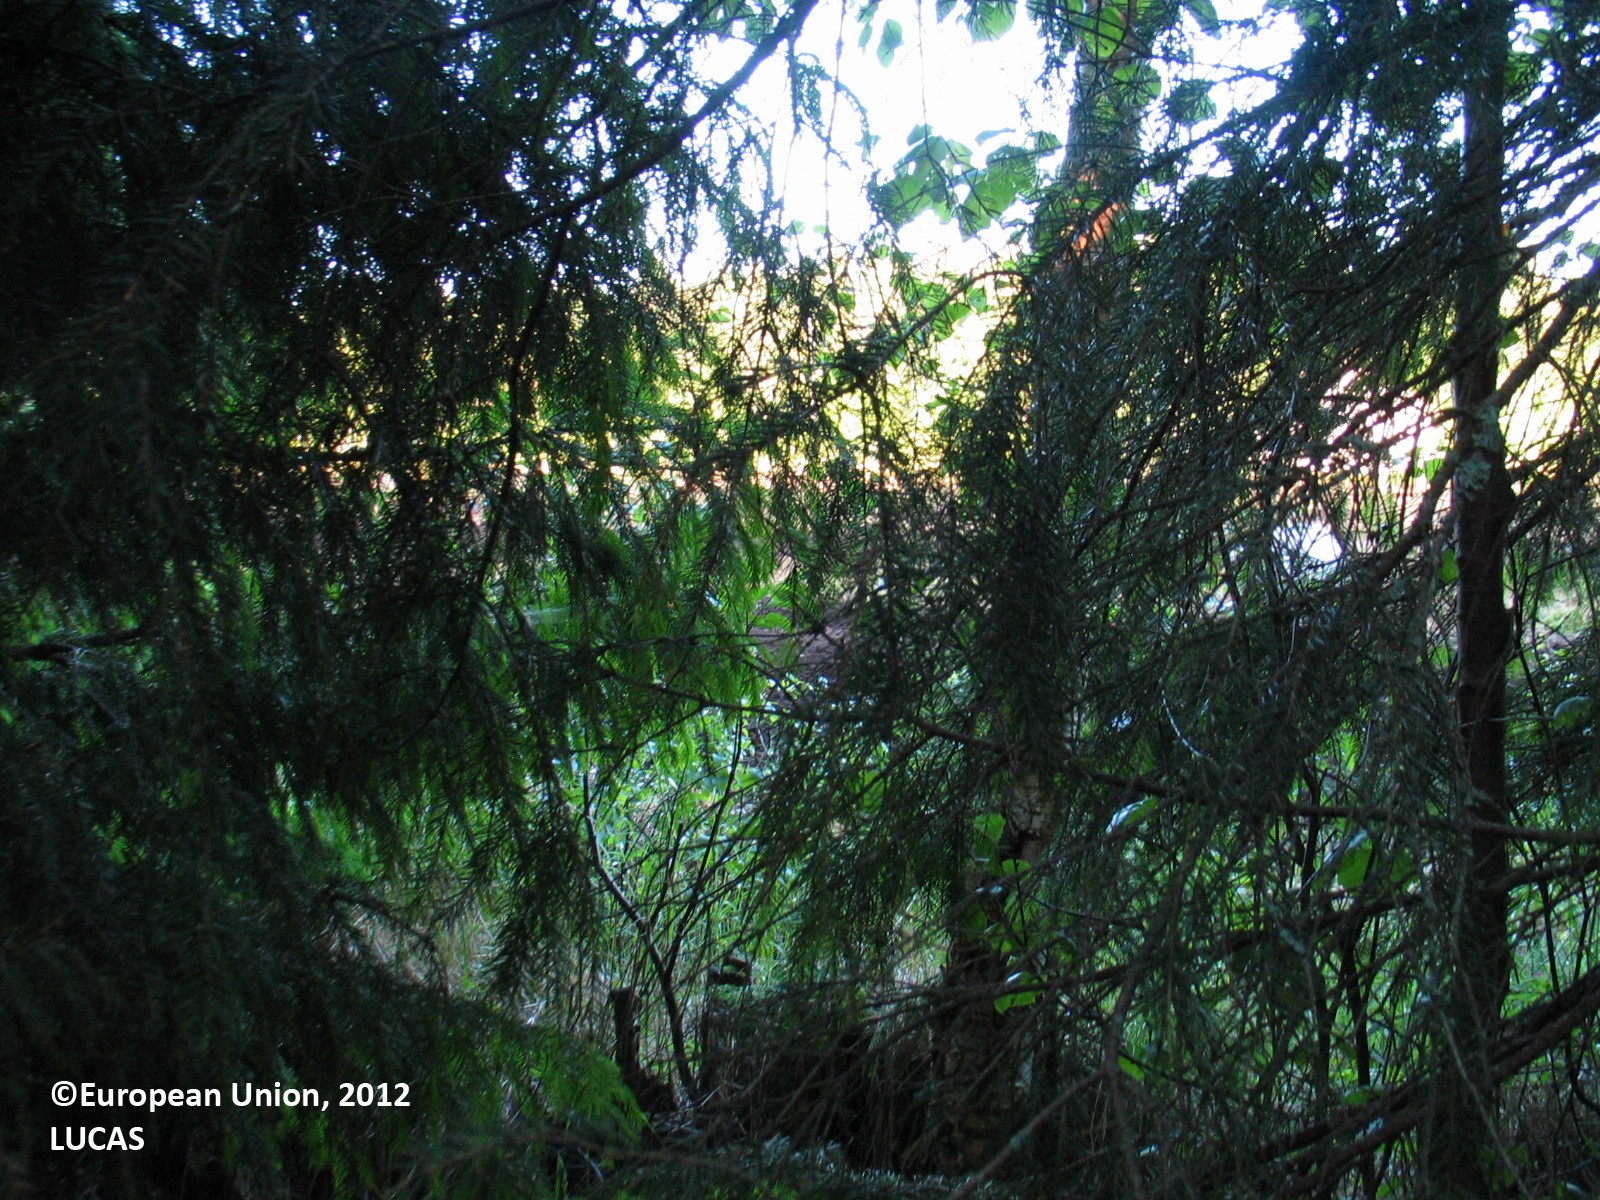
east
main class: Woodland
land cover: Spruce dominated coniferous woodland
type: boreal forest
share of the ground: 50 - 75 %
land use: Forestry
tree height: > 5 m
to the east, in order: Spruce dominated coniferous woodland; Ditches and canals; Grass margins; Oats; Ditches and canals; Oats; Ditches and canals; Oats; Grass margins; Ditches and canals; Grass margins; Oats; Ditches and canals; Oats; Grass margins; Ditches and canals; Grass margins; Oats; Ditches and canals; Oats; Ditches and canals; Oats; Grass margins; Ditches and canals; Grass margins; Oats; Grass margins; Ditches and canals; Other mixed woodland; Grassland with sparse tree/shrub cover; Ditches and canals; Other mixed woodland; Broadleaved woodland
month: June
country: FI
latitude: 65.1290
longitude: 25.4886
